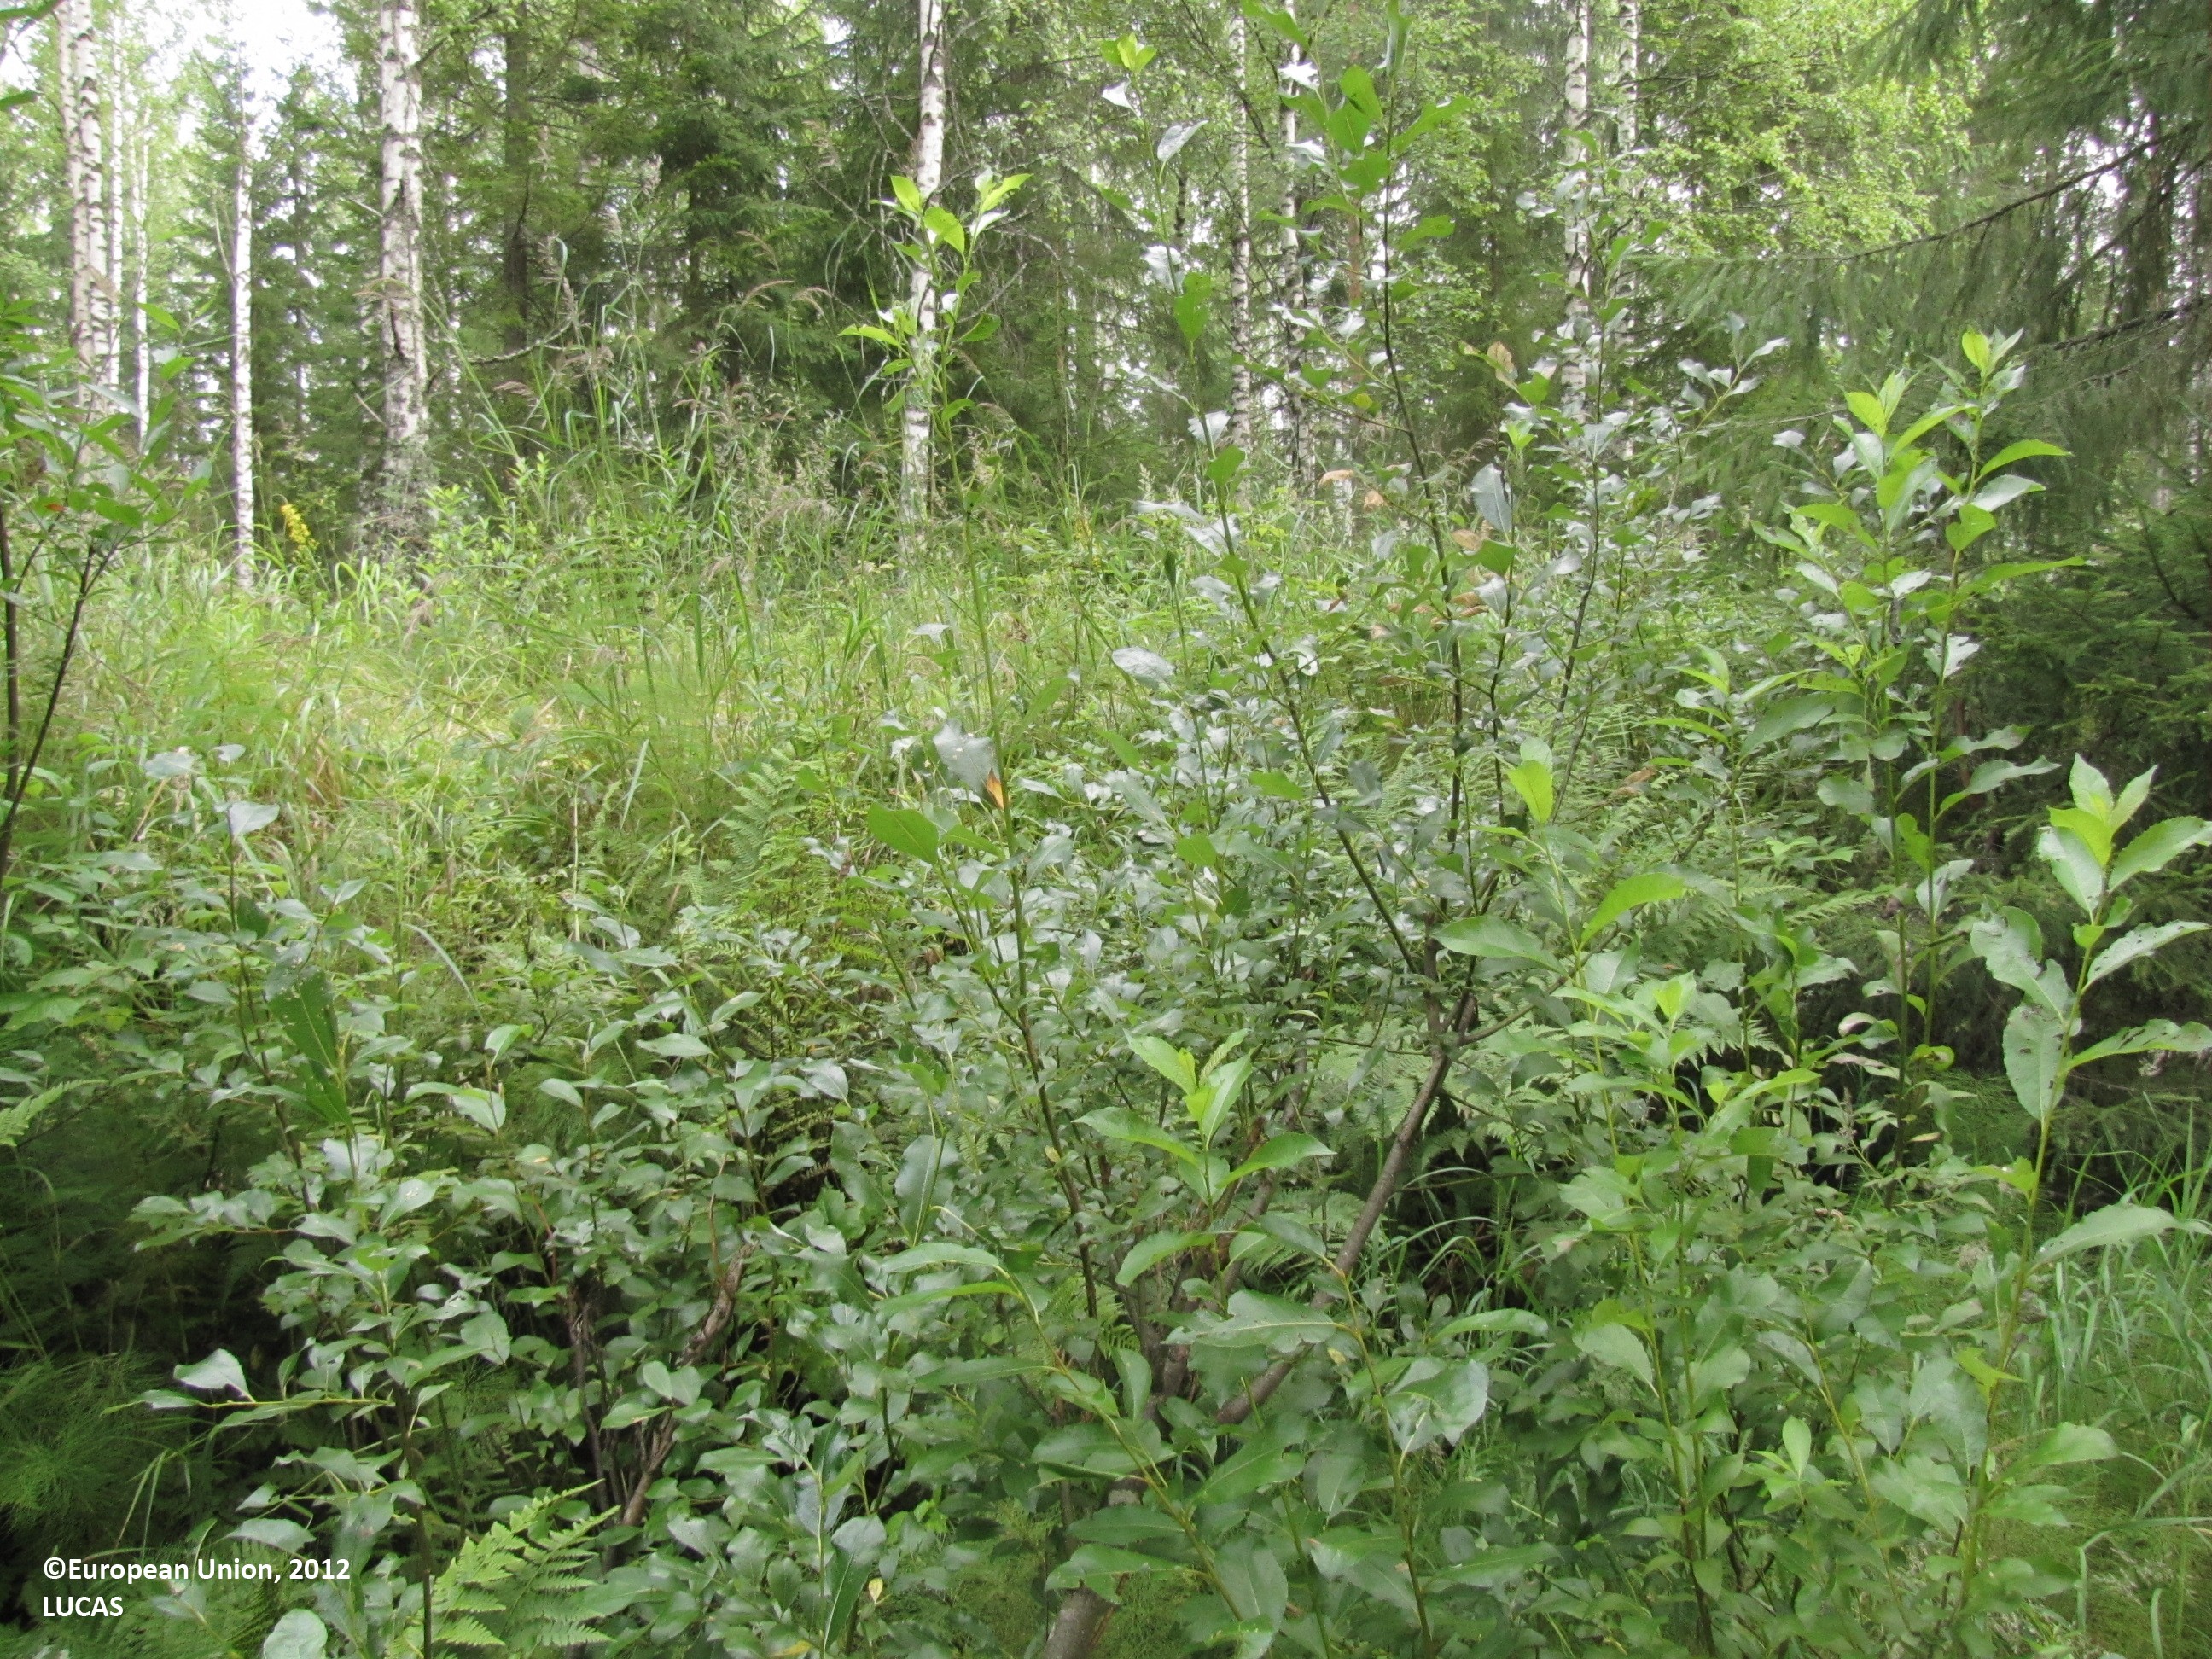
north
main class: Woodland
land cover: Other mixed woodland
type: boreal forest
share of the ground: 50 - 75 %
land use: Forestry
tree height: > 5 m
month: August
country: FI
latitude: 61.8956
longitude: 23.8401
